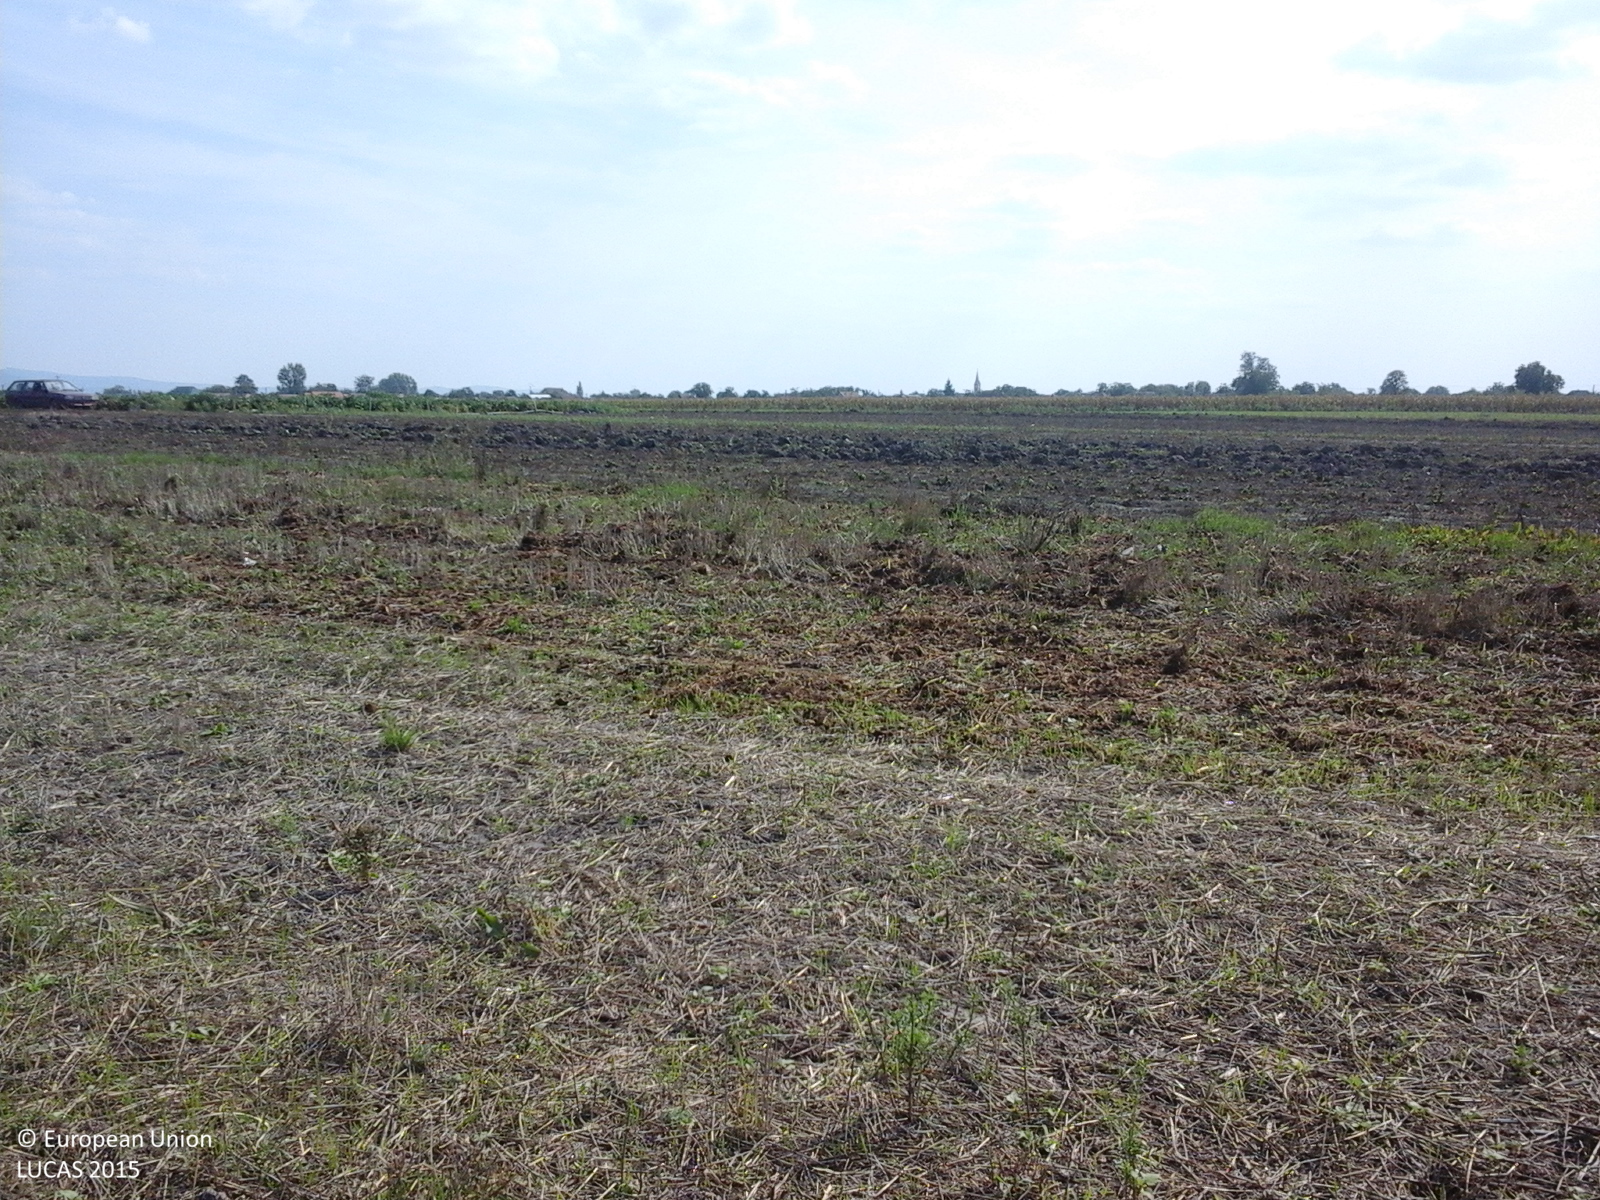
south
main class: Cropland
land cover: Common wheat
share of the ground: < 10 %
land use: Agriculture (excluding fallow land and kitchen gardens)
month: August
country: RO
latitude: 46.3964
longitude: 21.5478
